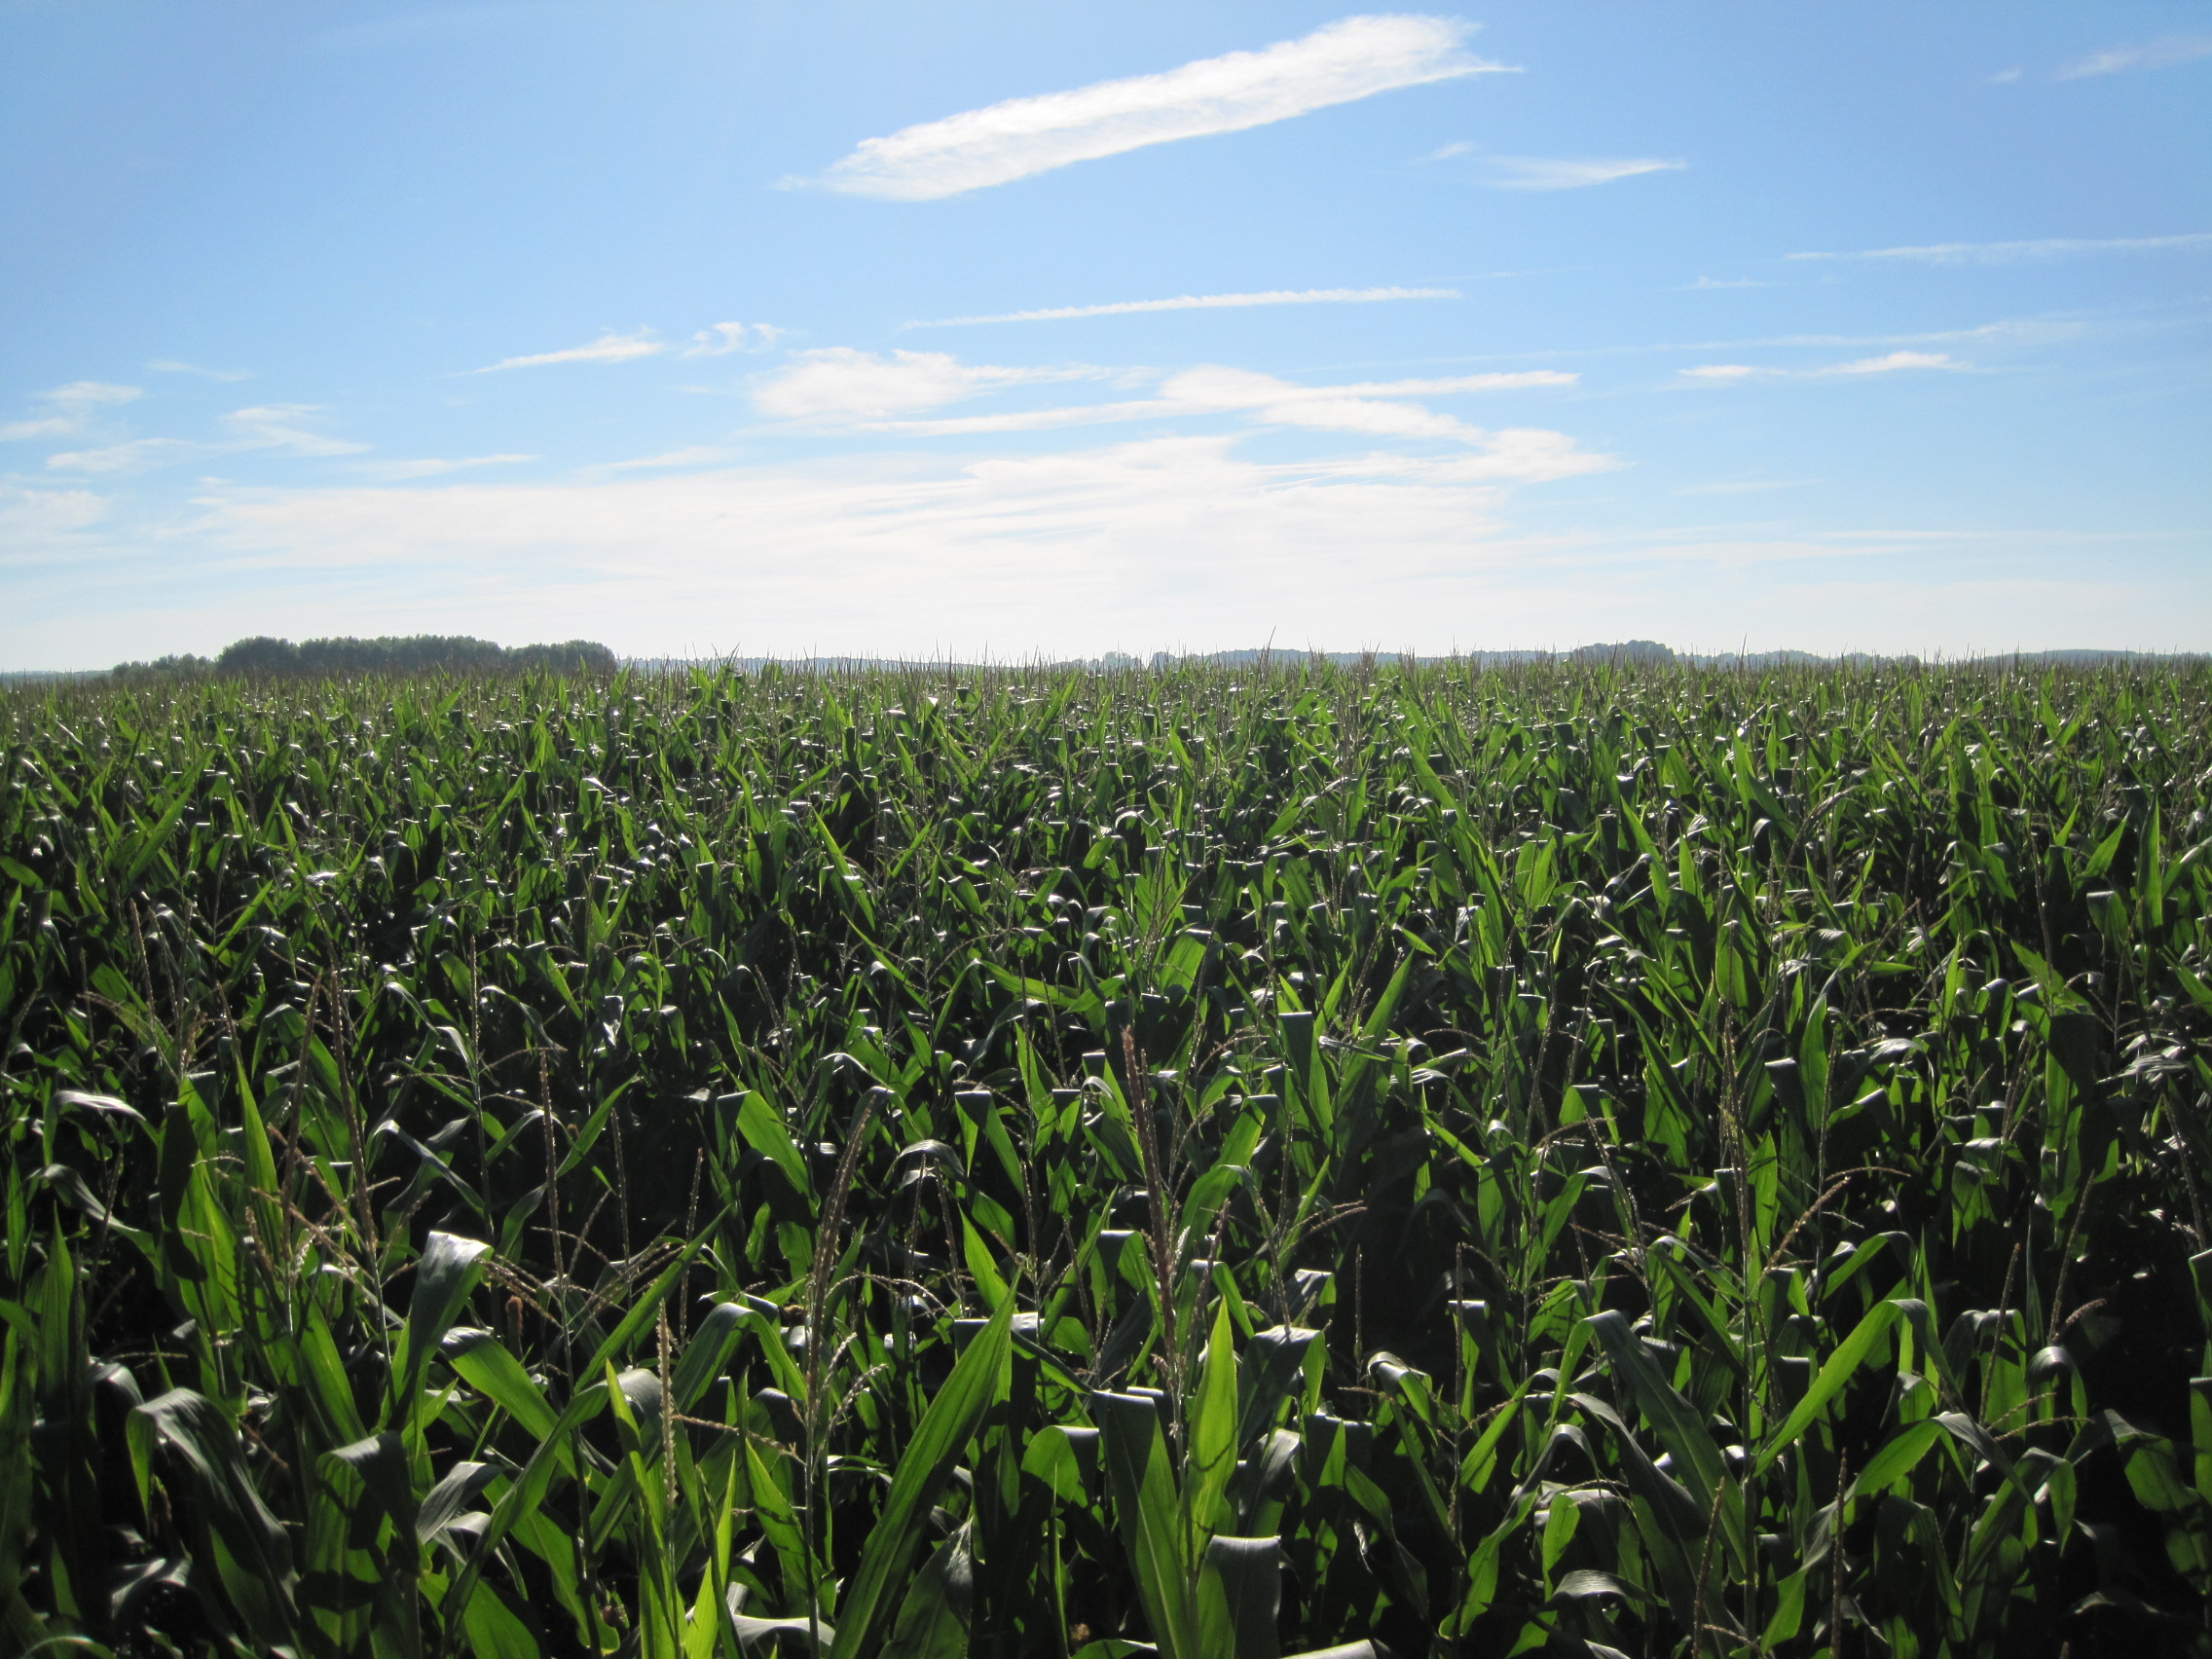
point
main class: Cropland
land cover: Maize
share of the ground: > 75 %
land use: Agriculture (excluding fallow land and kitchen gardens)
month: July
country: ES
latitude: 42.0189
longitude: -5.6334
